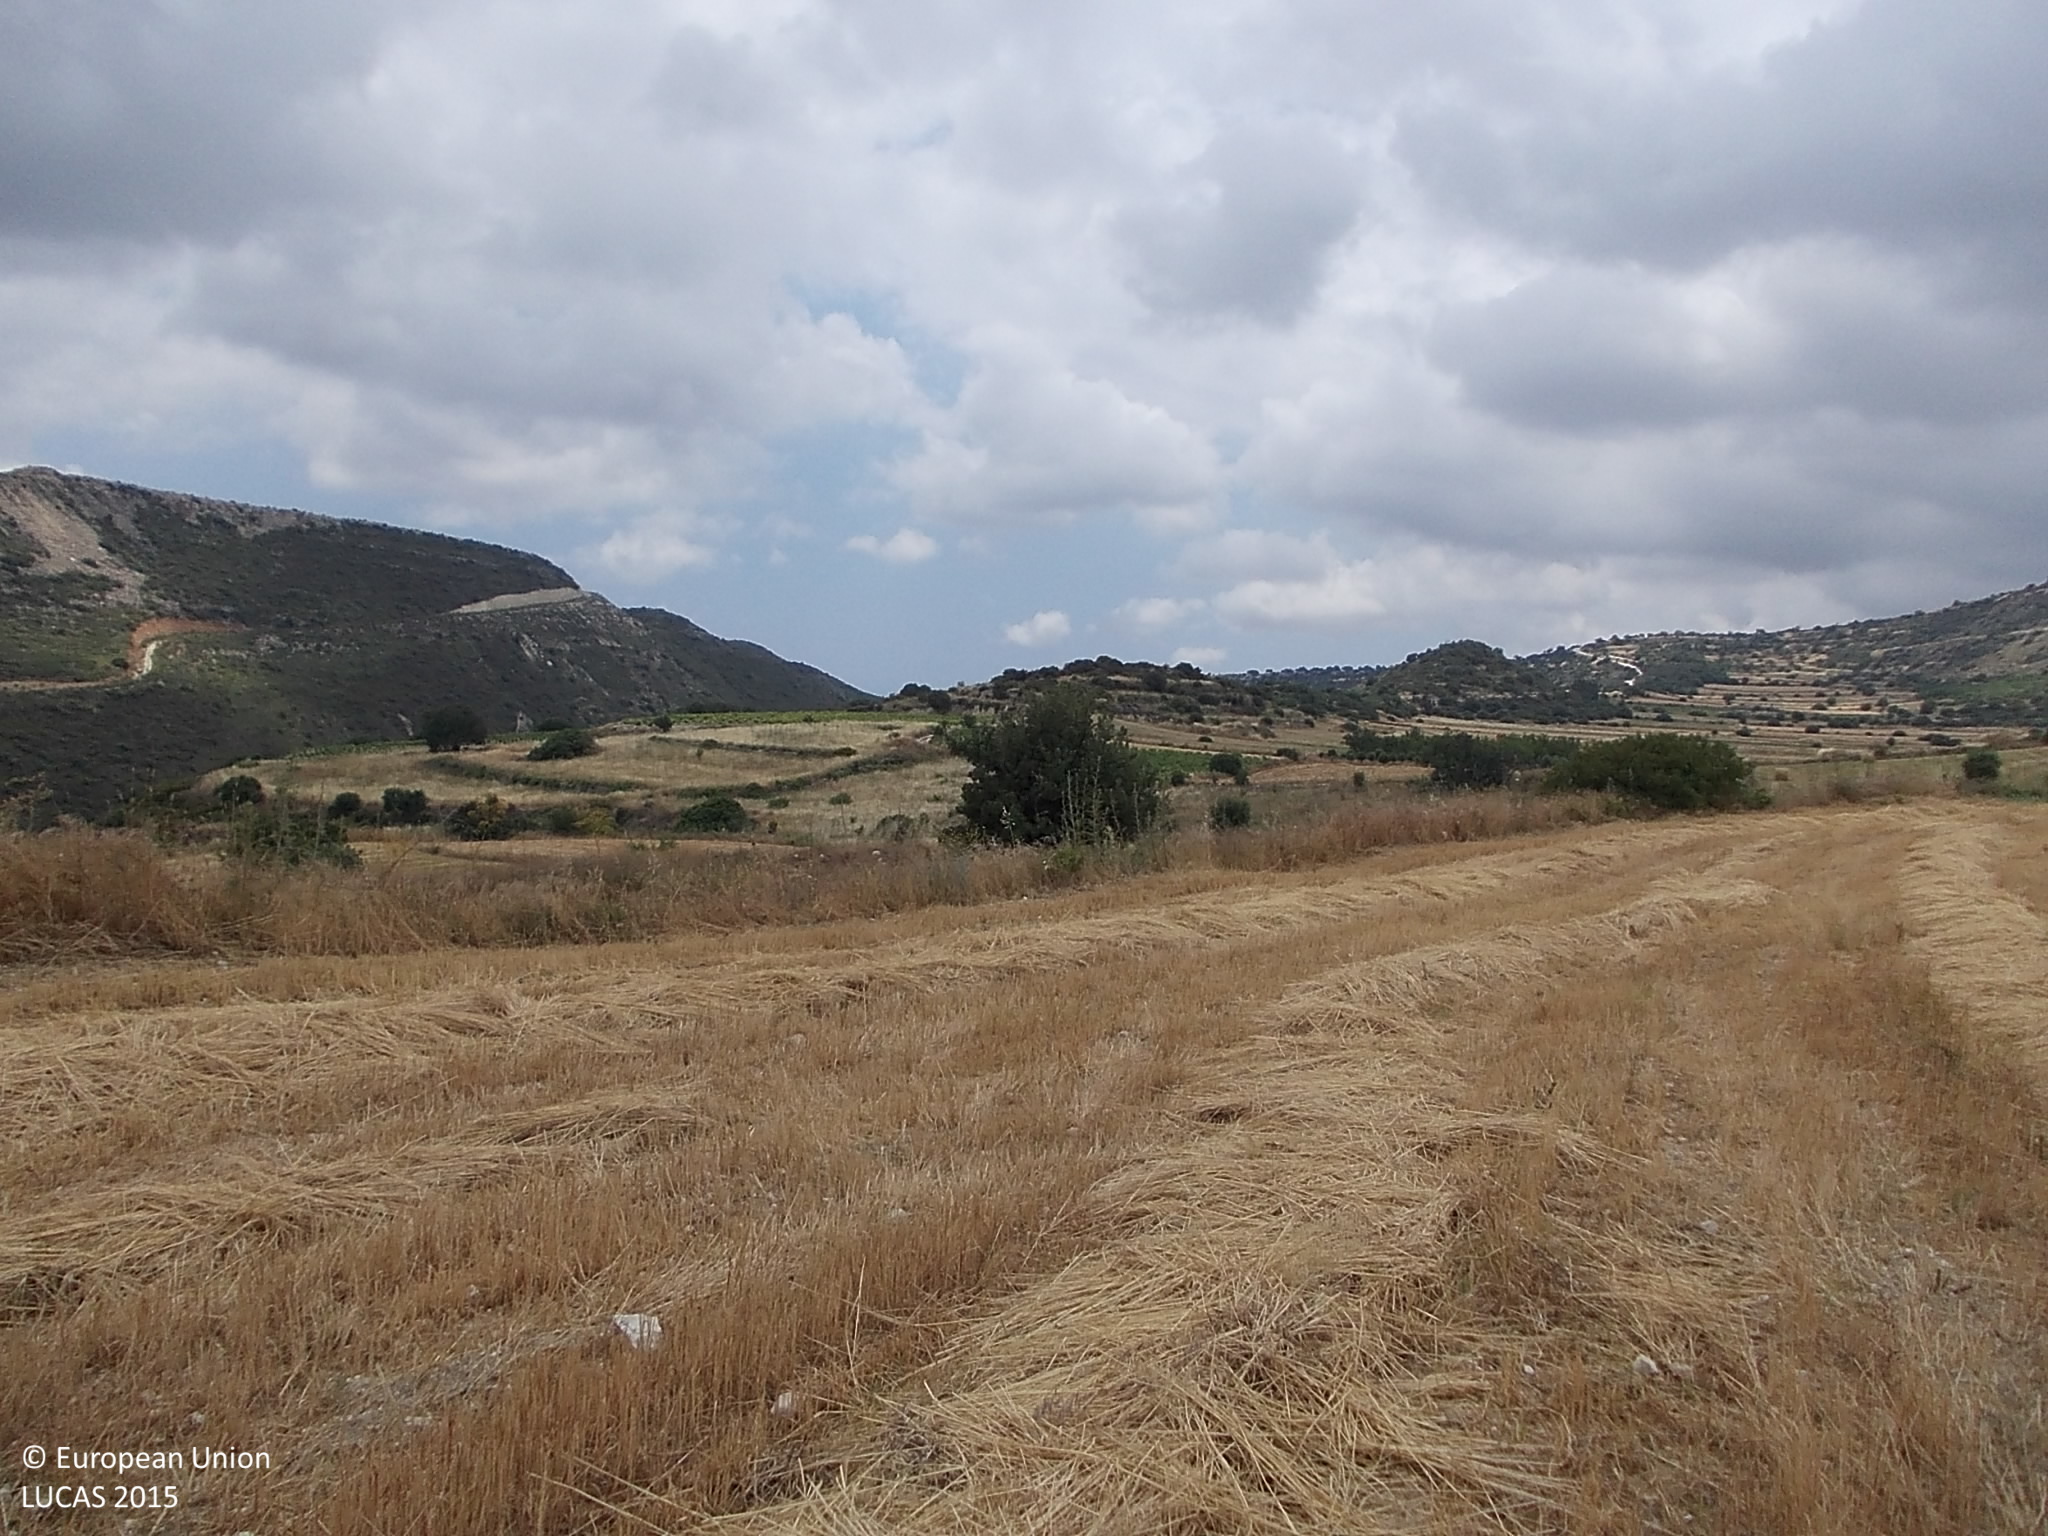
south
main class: Cropland
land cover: Oats
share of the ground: > 75 %
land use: Agriculture (excluding fallow land and kitchen gardens)
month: May
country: CY
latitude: 34.7678
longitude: 32.8083
